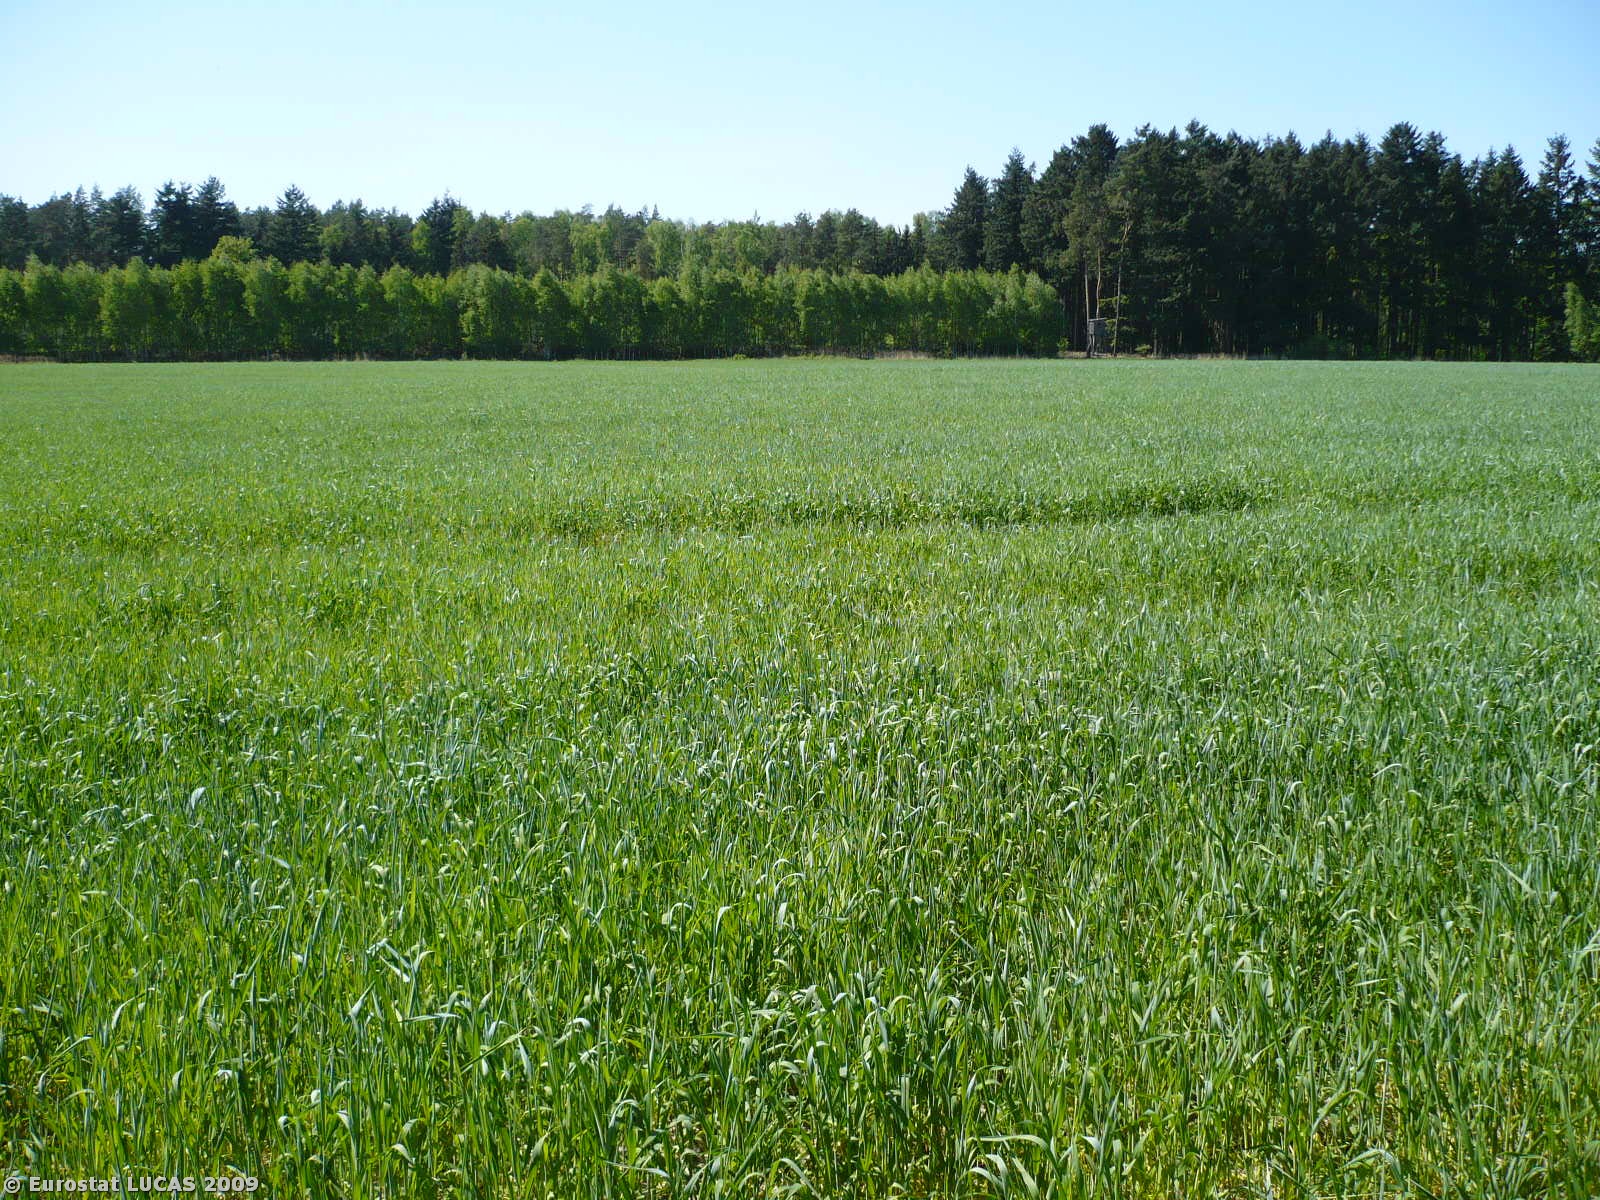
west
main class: Cropland
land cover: Rye
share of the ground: > 75 %
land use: Agriculture (excluding fallow land and kitchen gardens)
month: May
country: PL
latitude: 52.1689
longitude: 15.6922
